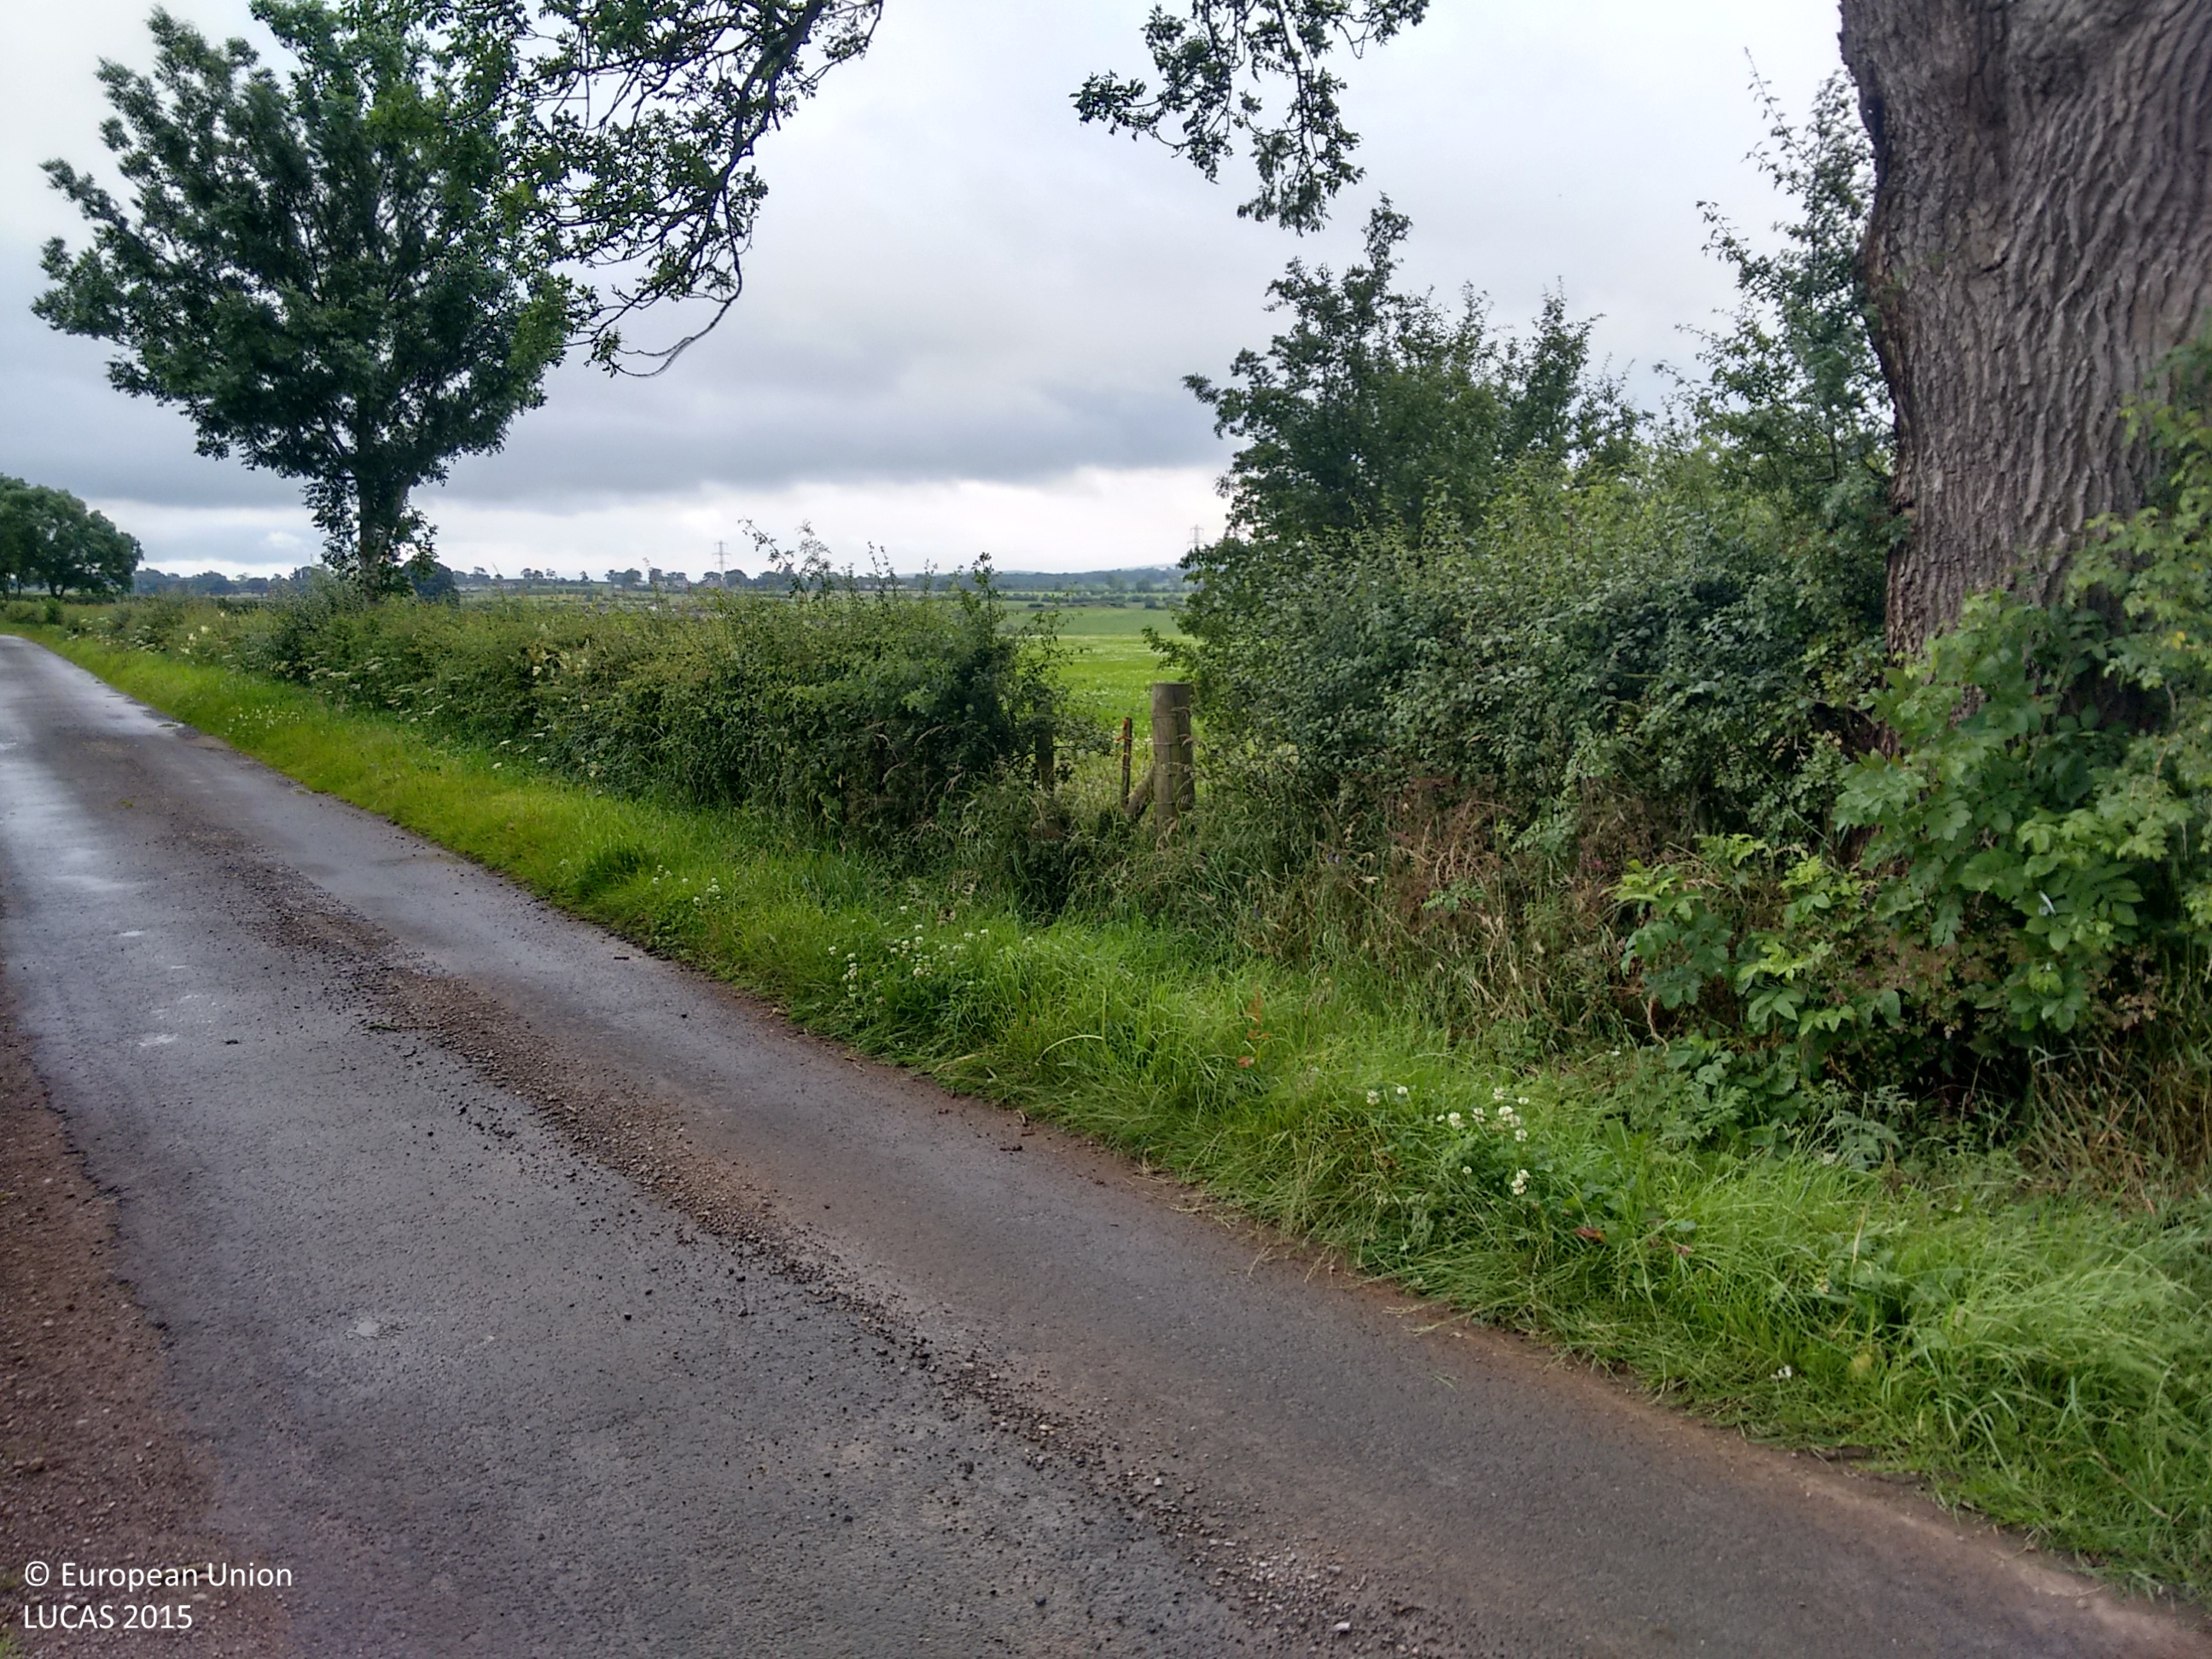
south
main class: Cropland
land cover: Barley
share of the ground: > 75 %
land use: Agriculture (excluding fallow land and kitchen gardens)
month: August
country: GB
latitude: 54.7537
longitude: -2.8570
